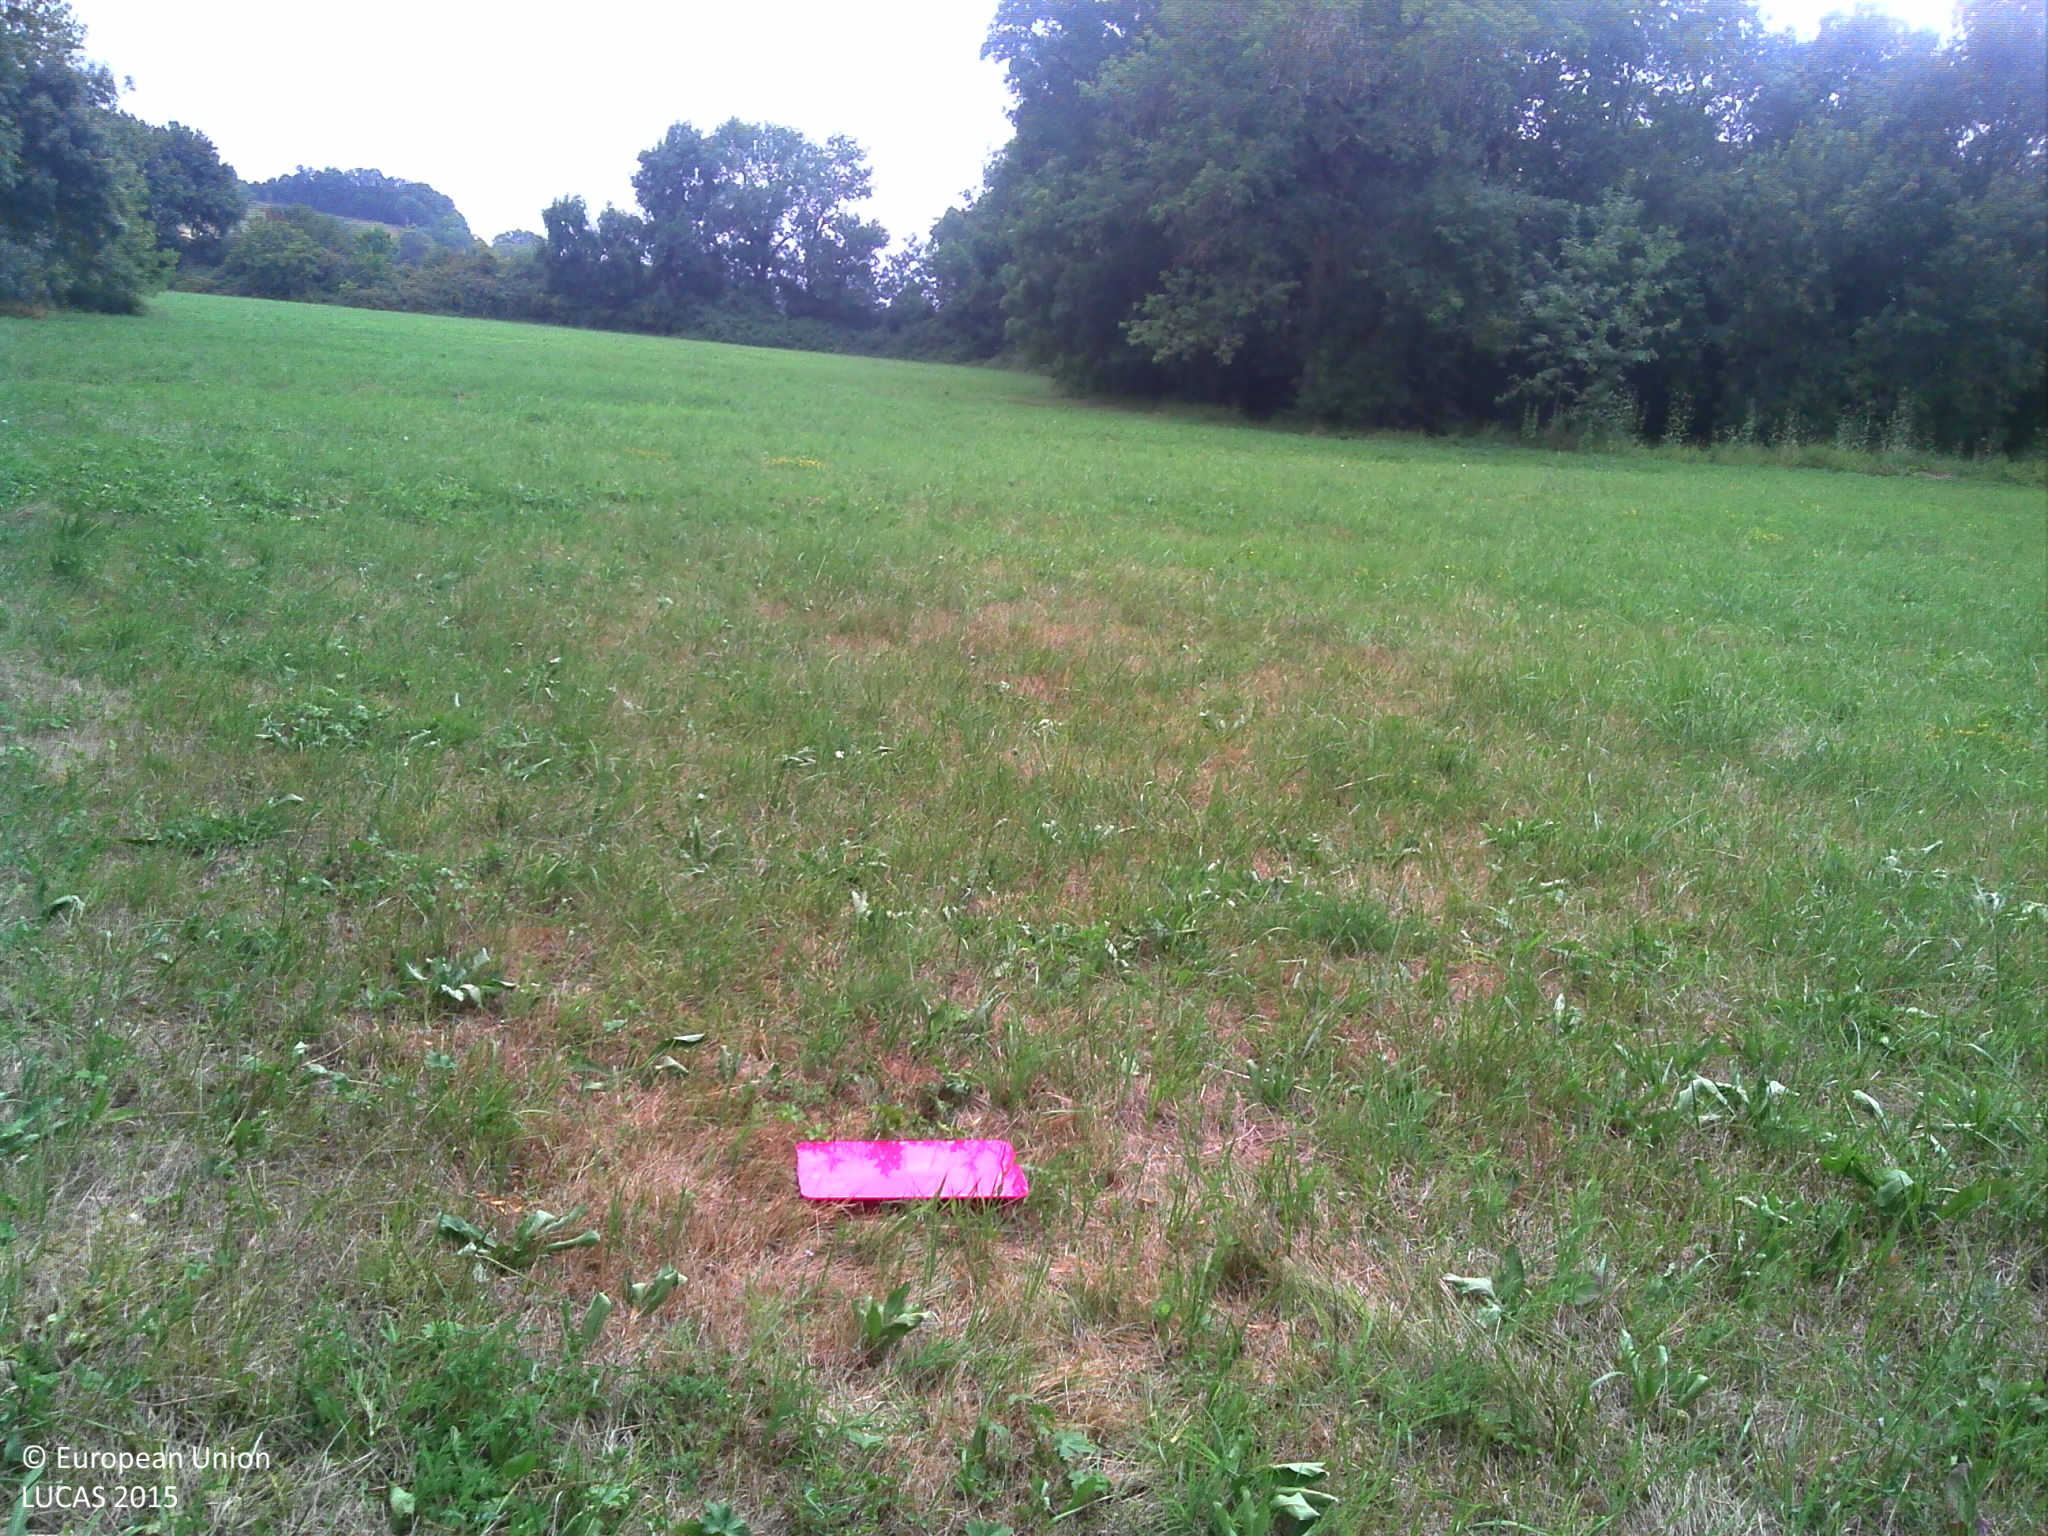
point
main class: Grassland
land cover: Grassland without tree/shrub cover
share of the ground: > 75 %
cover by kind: herbaceous plants 100 %
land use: Agriculture (excluding fallow land and kitchen gardens)
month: July
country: FR
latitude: 43.8059
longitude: 0.9121
